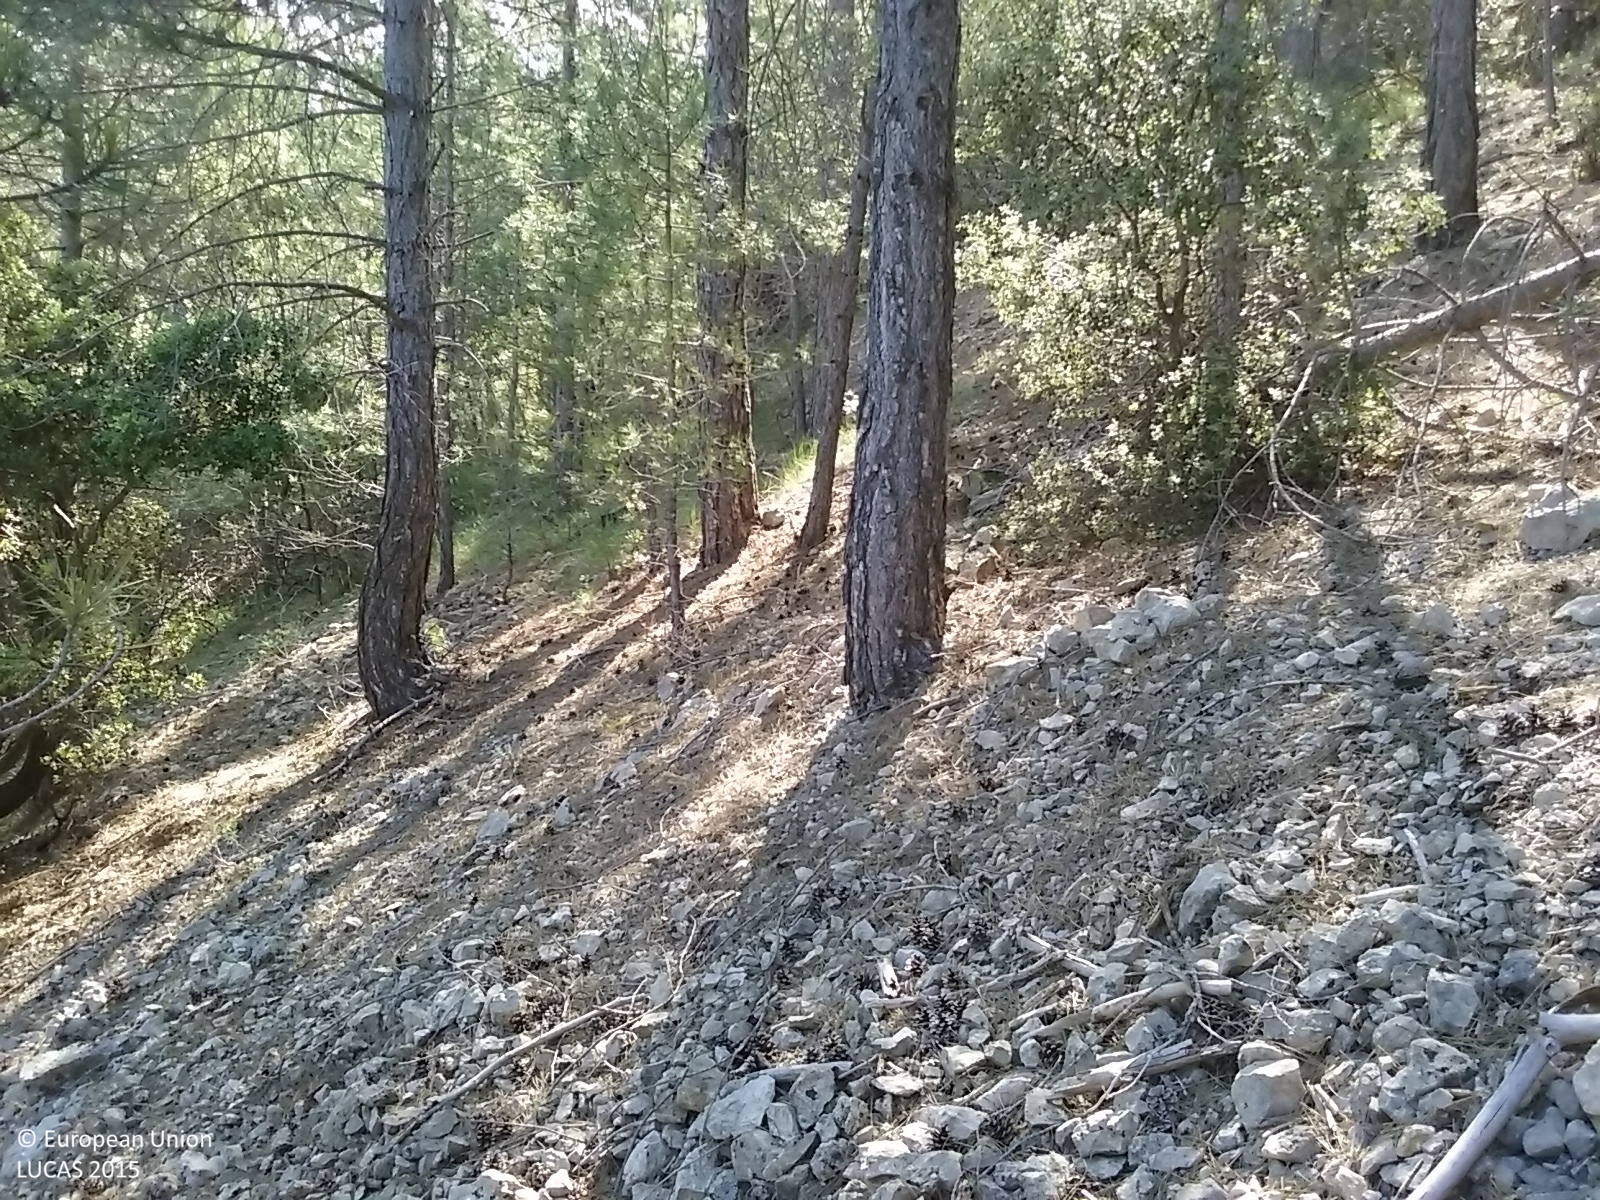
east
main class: Woodland
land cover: Pine dominated mixed woodland
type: coniferous forest of the mediterranean region
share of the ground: > 75 %
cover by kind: coniferous forest trees 45 %, broadleaved forest trees 35 %, herbaceous plants 10 %, shrubs 5 %, unconsolidated bare surface 5 %
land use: Forestry
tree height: > 5 m
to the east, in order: Pine dominated mixed woodland
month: June
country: ES
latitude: 40.7014
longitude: -0.0084
